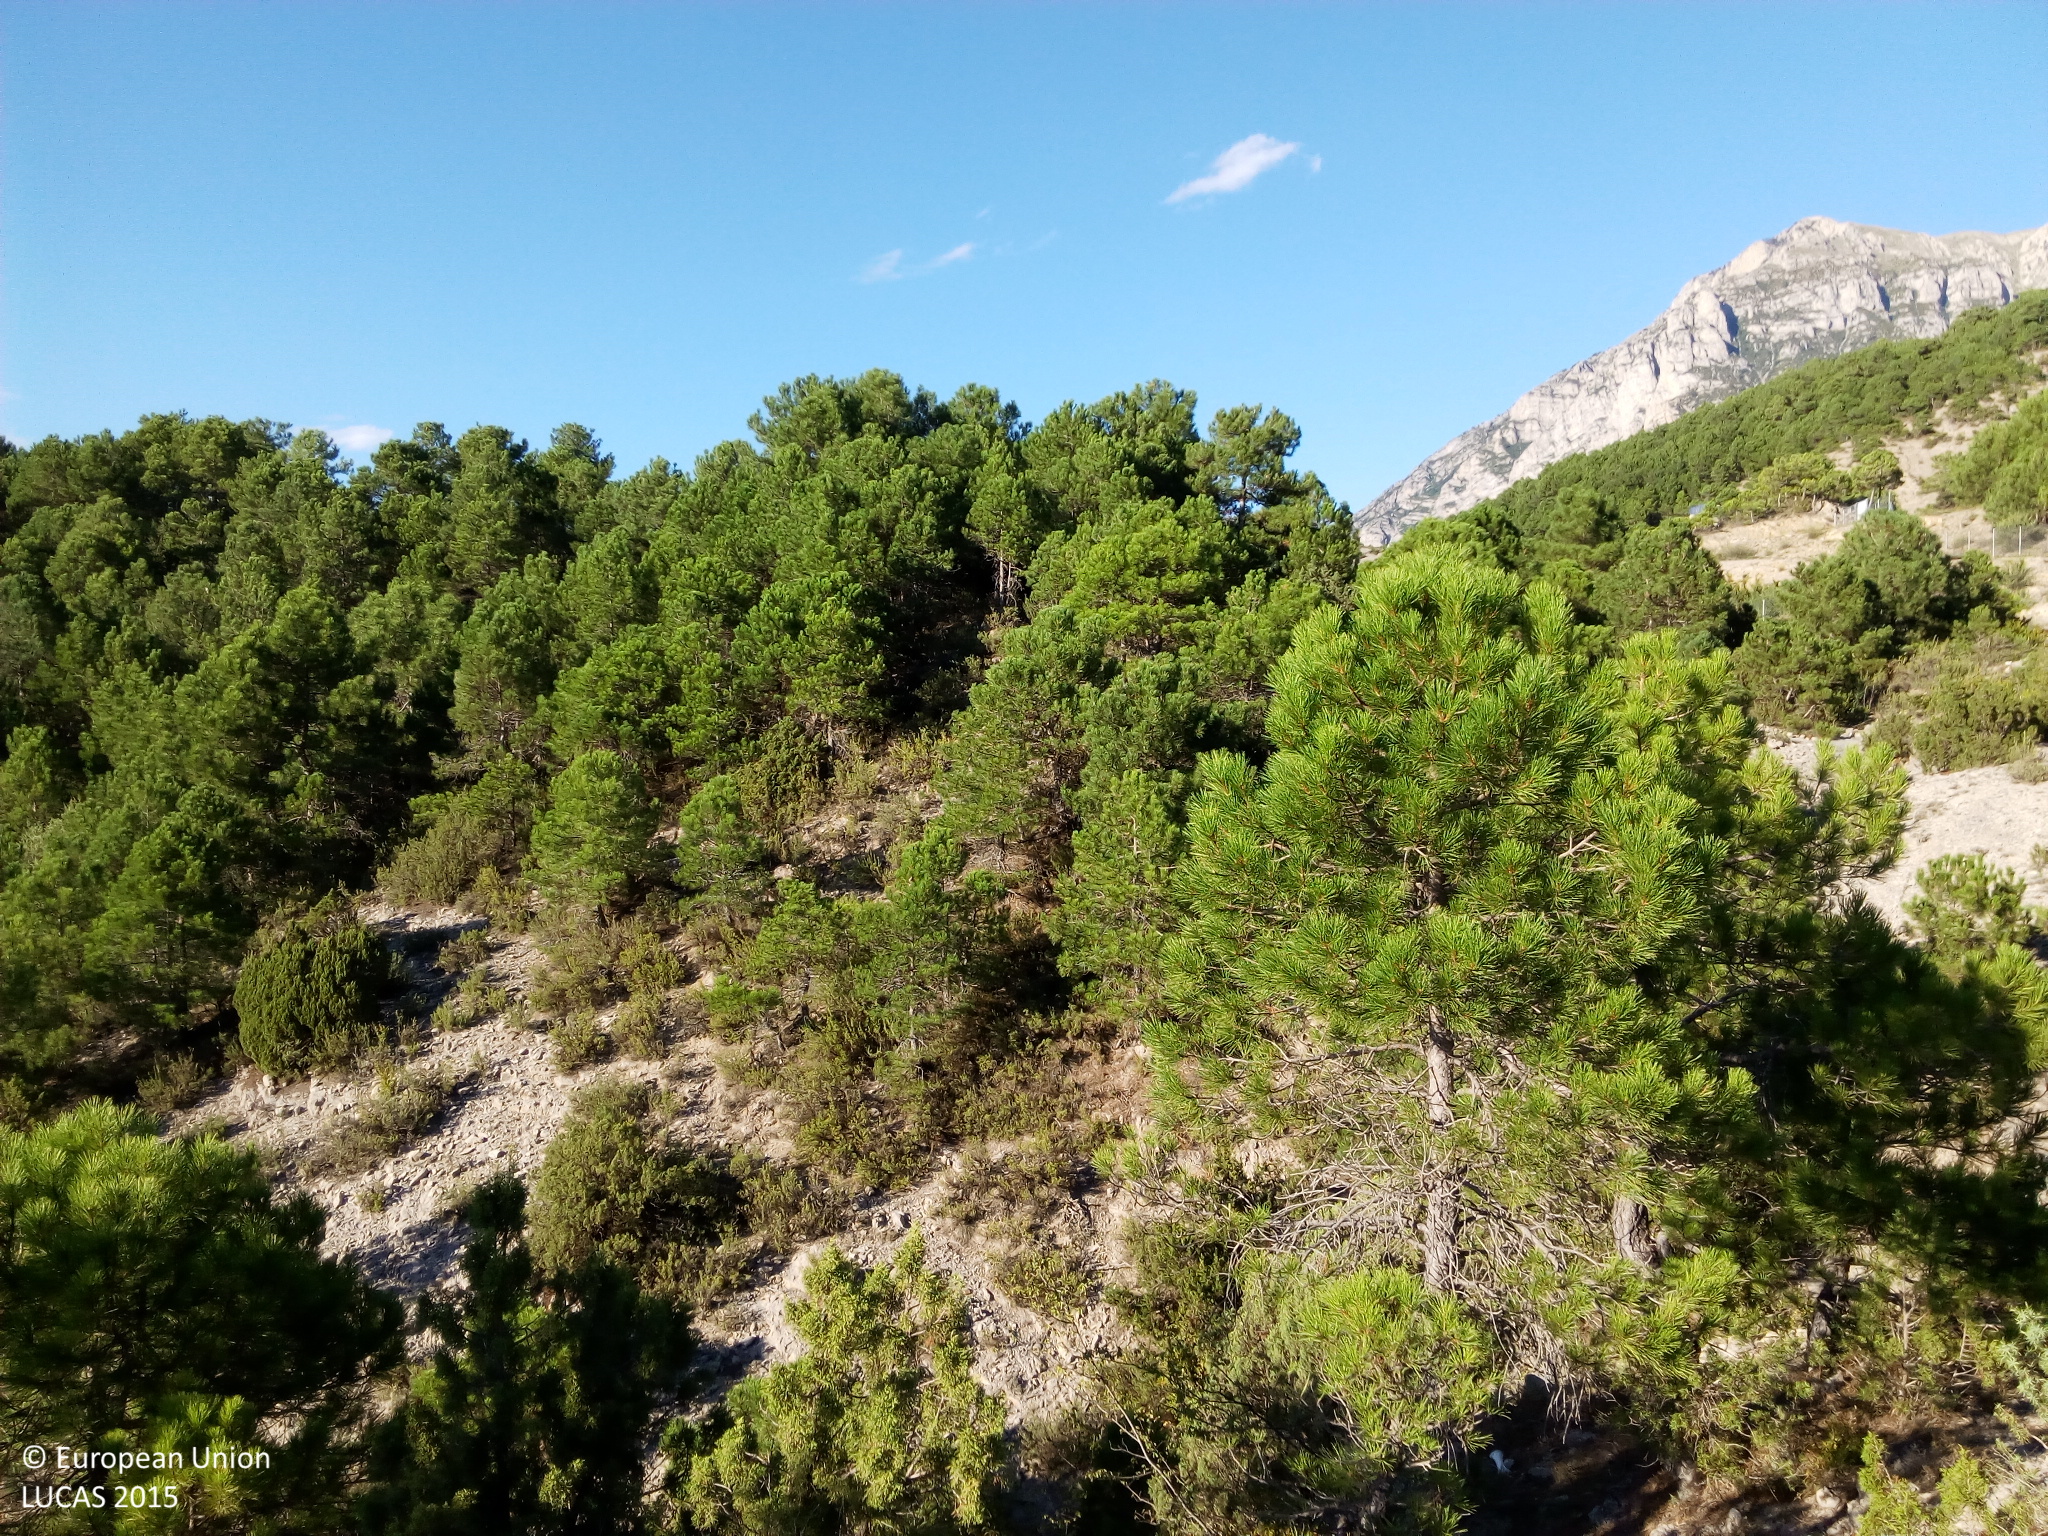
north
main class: Woodland
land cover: Pine dominated coniferous woodland
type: coniferous forest of the mediterranean region
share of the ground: > 75 %
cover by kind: coniferous forest trees 80 %, consolidated bare surface 20 %
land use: Semi-natural and natural areas not in use
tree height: > 5 m
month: August
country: ES
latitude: 42.5211
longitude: 0.1793
